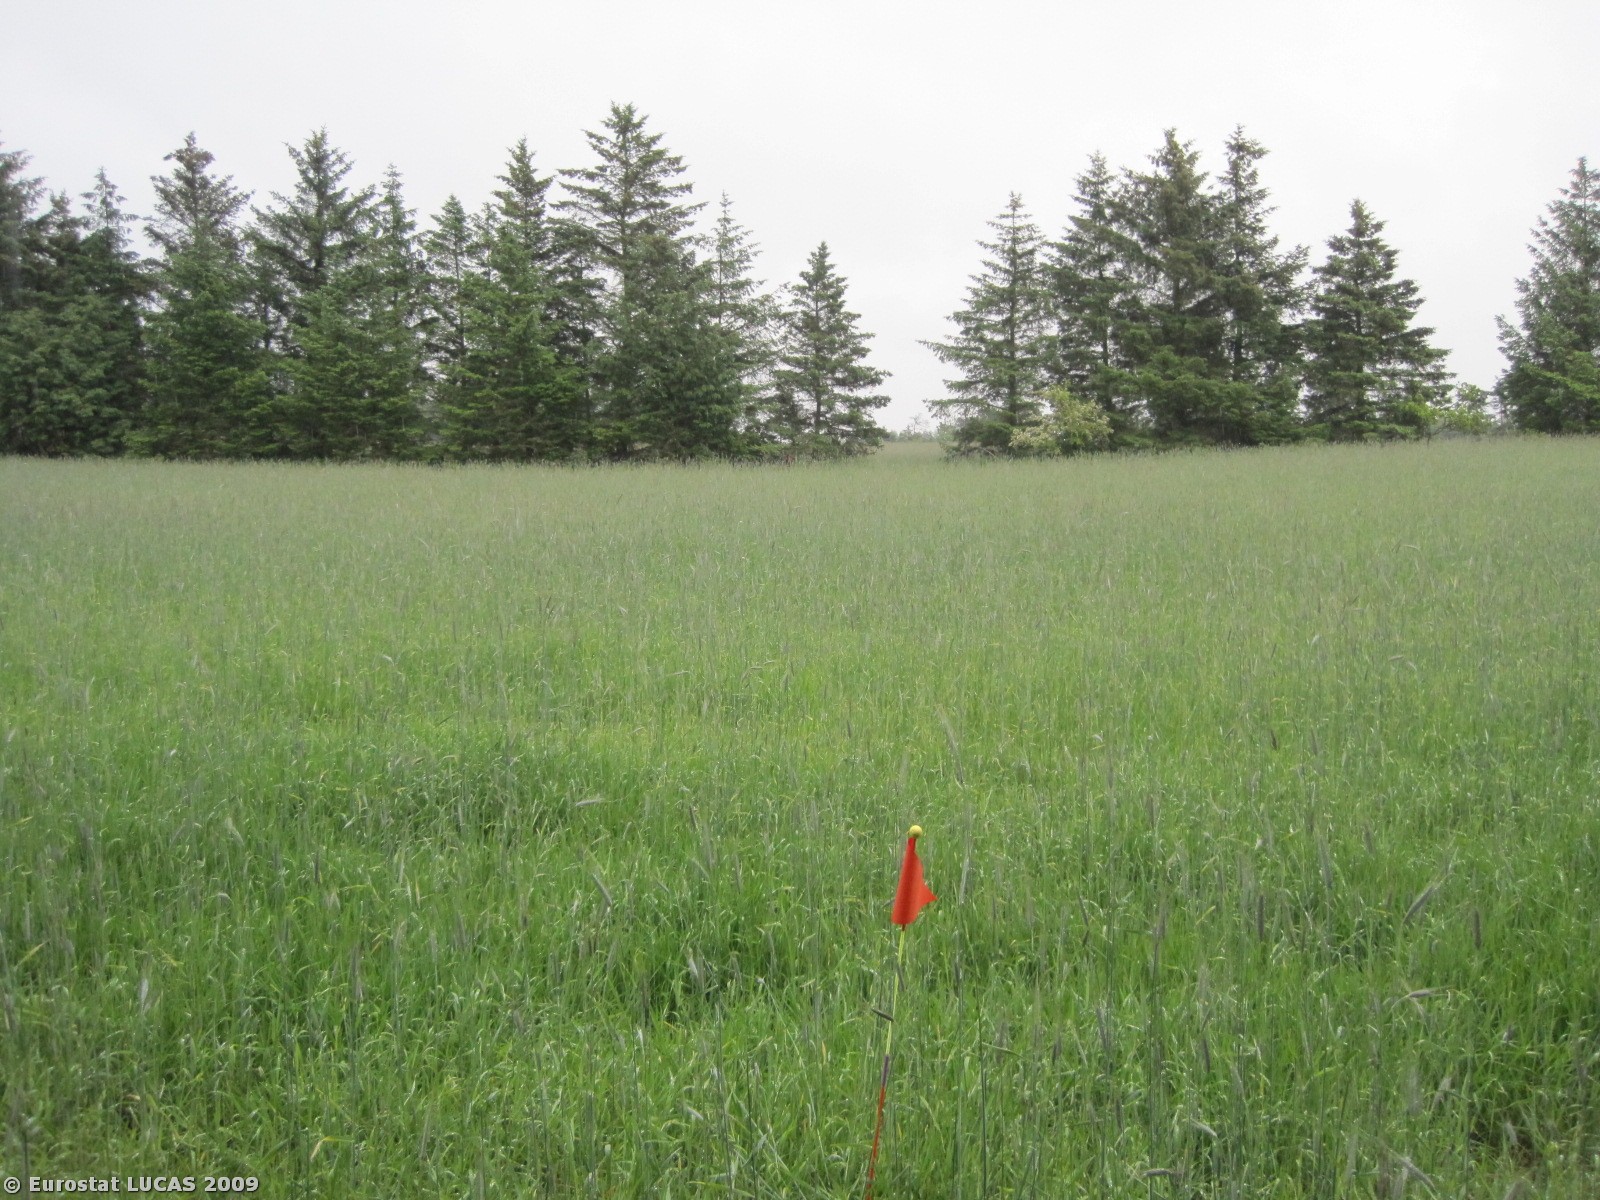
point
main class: Grassland
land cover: Grassland without tree/shrub cover
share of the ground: > 75 %
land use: Agriculture (excluding fallow land and kitchen gardens)
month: June
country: DK
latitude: 57.4641
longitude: 10.1498
